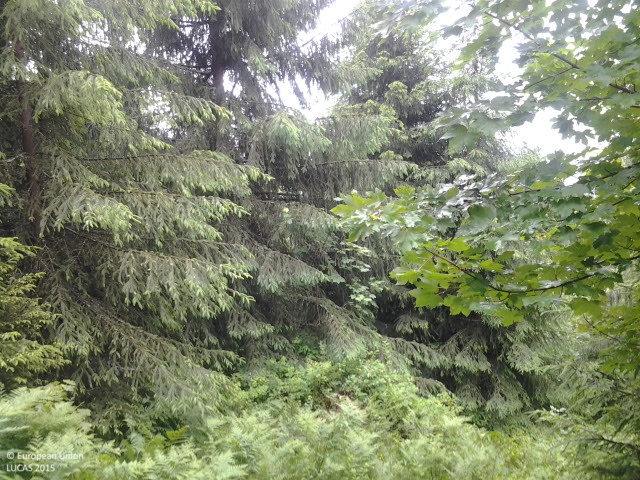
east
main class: Woodland
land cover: Spruce dominated mixed woodland
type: alpine coniferous forest
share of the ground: > 75 %
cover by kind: coniferous forest trees 70 %, broadleaved forest trees 30 %
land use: Forestry
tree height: > 5 m
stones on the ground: 25 - 50 %
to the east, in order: Spruce dominated mixed woodland; Fences; Spruce dominated mixed woodland; Tracks; Fences; Lines of trees; Grassland without tree/shrub cover; Lines of trees; Grassland without tree/shrub cover
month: June
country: RO
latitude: 47.2581
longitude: 25.2933
